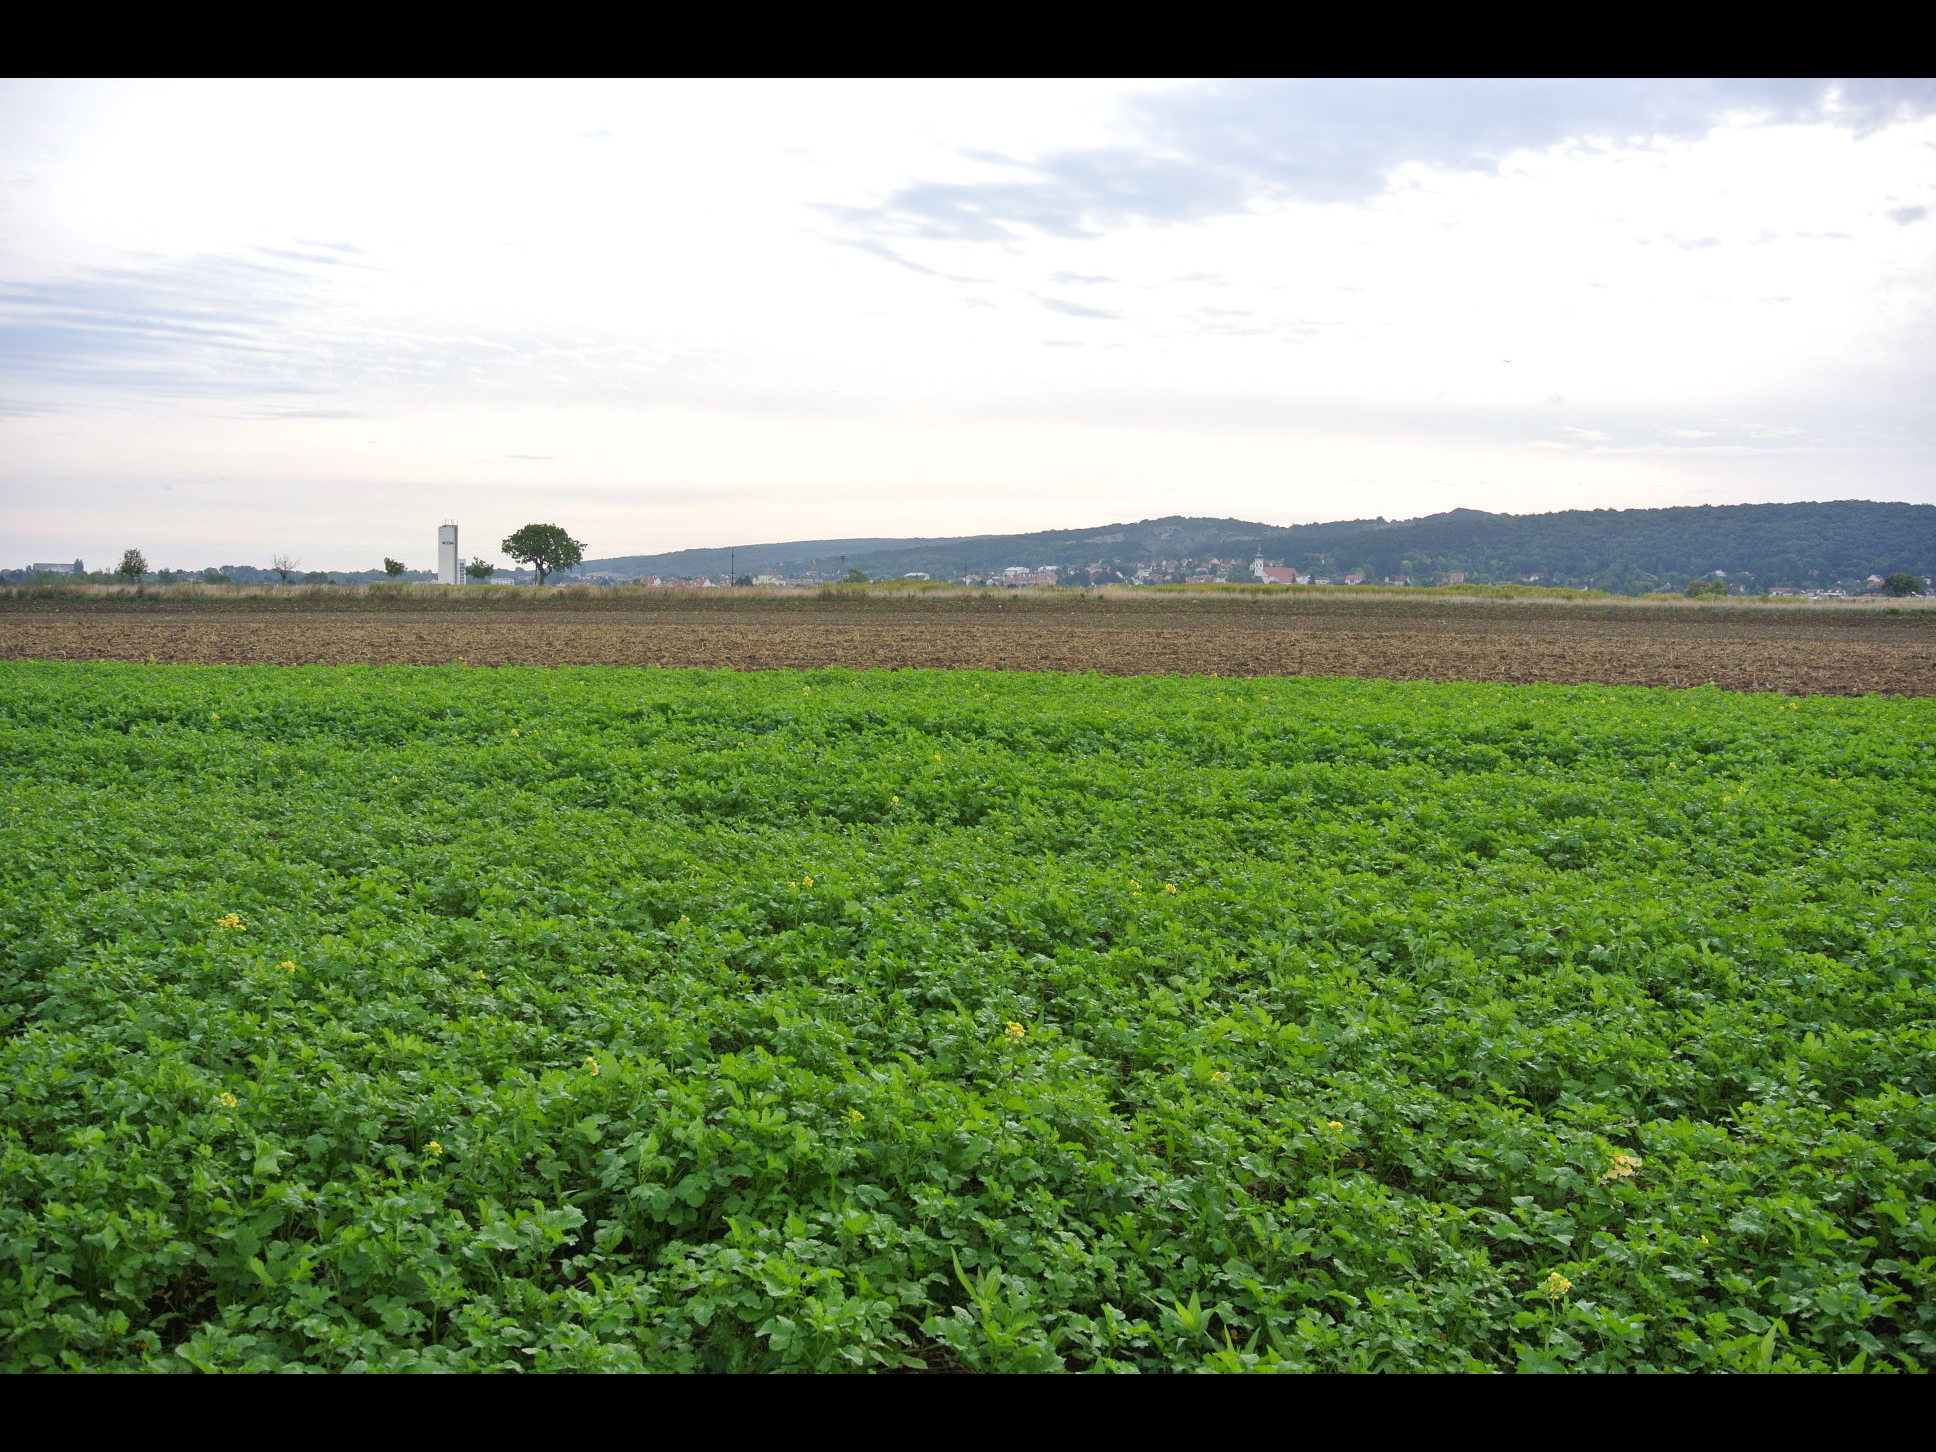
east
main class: Cropland
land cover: Rape and turnip rape
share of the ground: > 75 %
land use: Agriculture (excluding fallow land and kitchen gardens)
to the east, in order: Rape and turnip rape; Common wheat; Other bare soil; Grassland without tree/shrub cover; Spontaneously vegetated surfaces; Other bare soil; Spontaneously vegetated surfaces
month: May
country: AT
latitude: 47.9726
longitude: 16.5825
